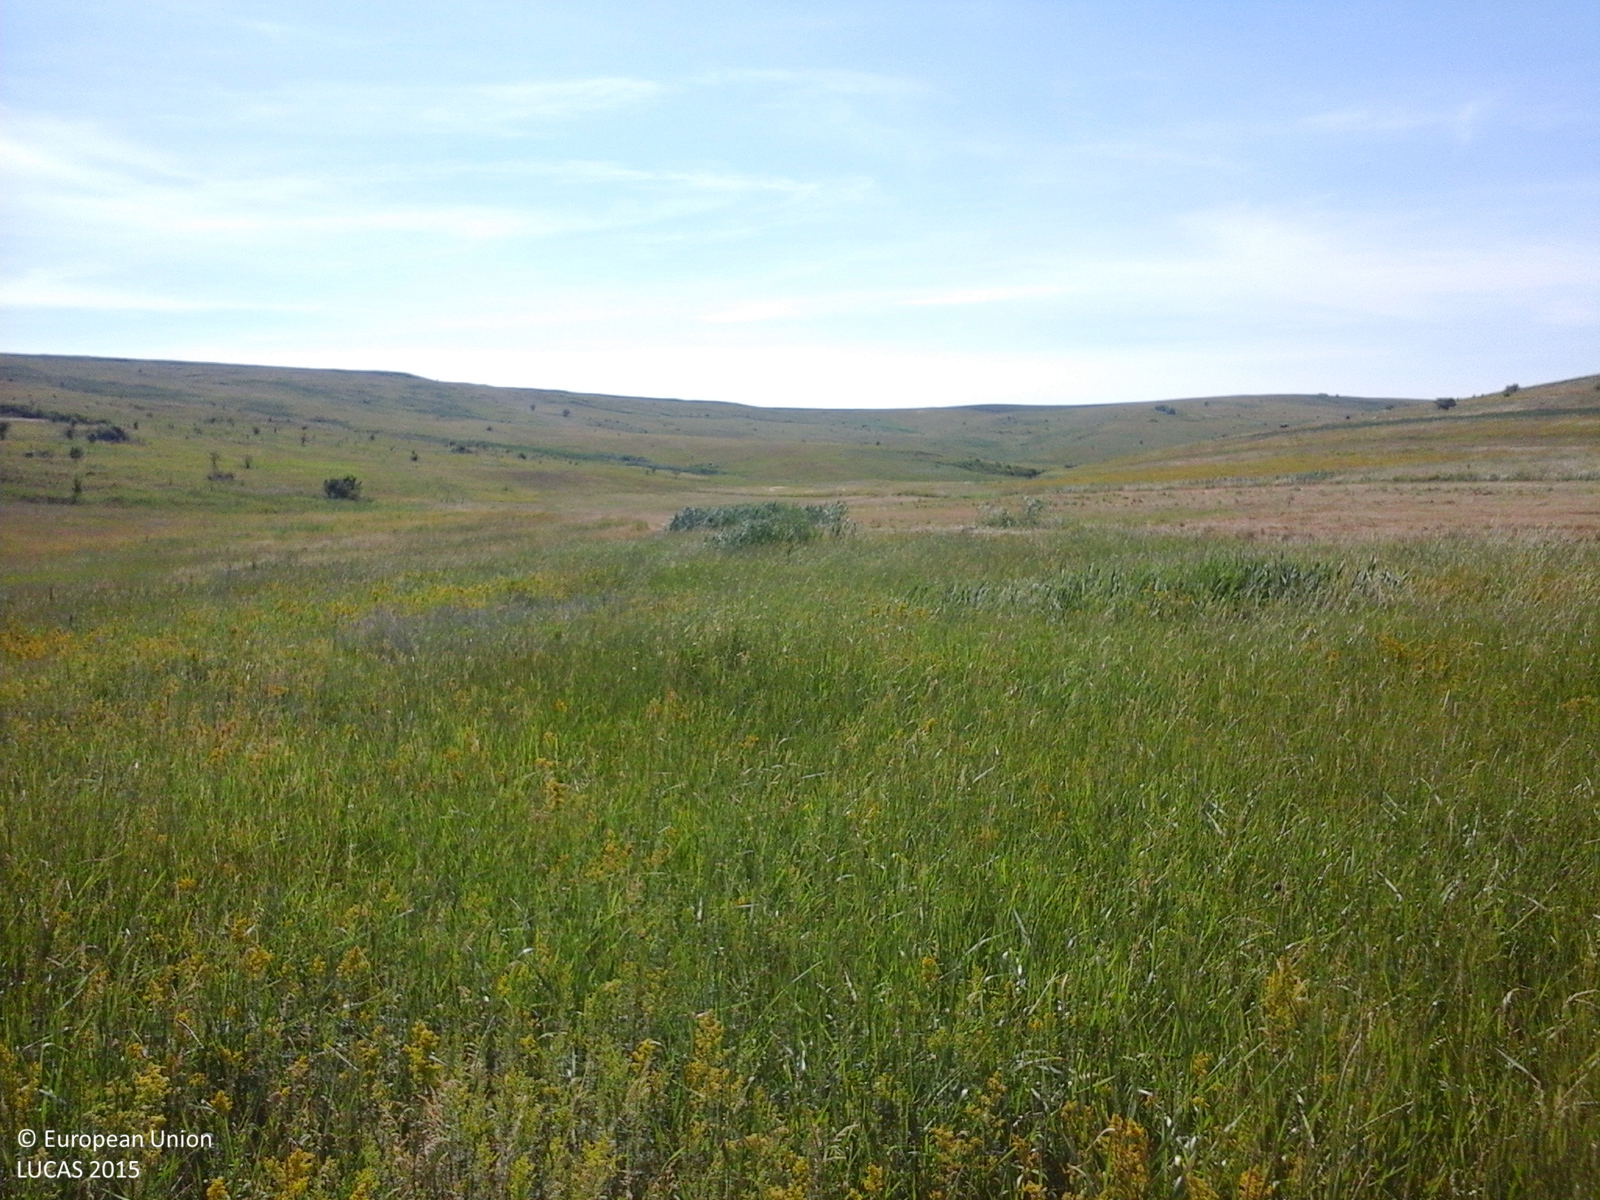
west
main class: Grassland
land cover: Grassland without tree/shrub cover
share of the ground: > 75 %
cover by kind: herbaceous plants 100 %
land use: Agriculture (excluding fallow land and kitchen gardens)
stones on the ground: < 10 %
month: June
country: RO
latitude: 47.7924
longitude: 26.9917
